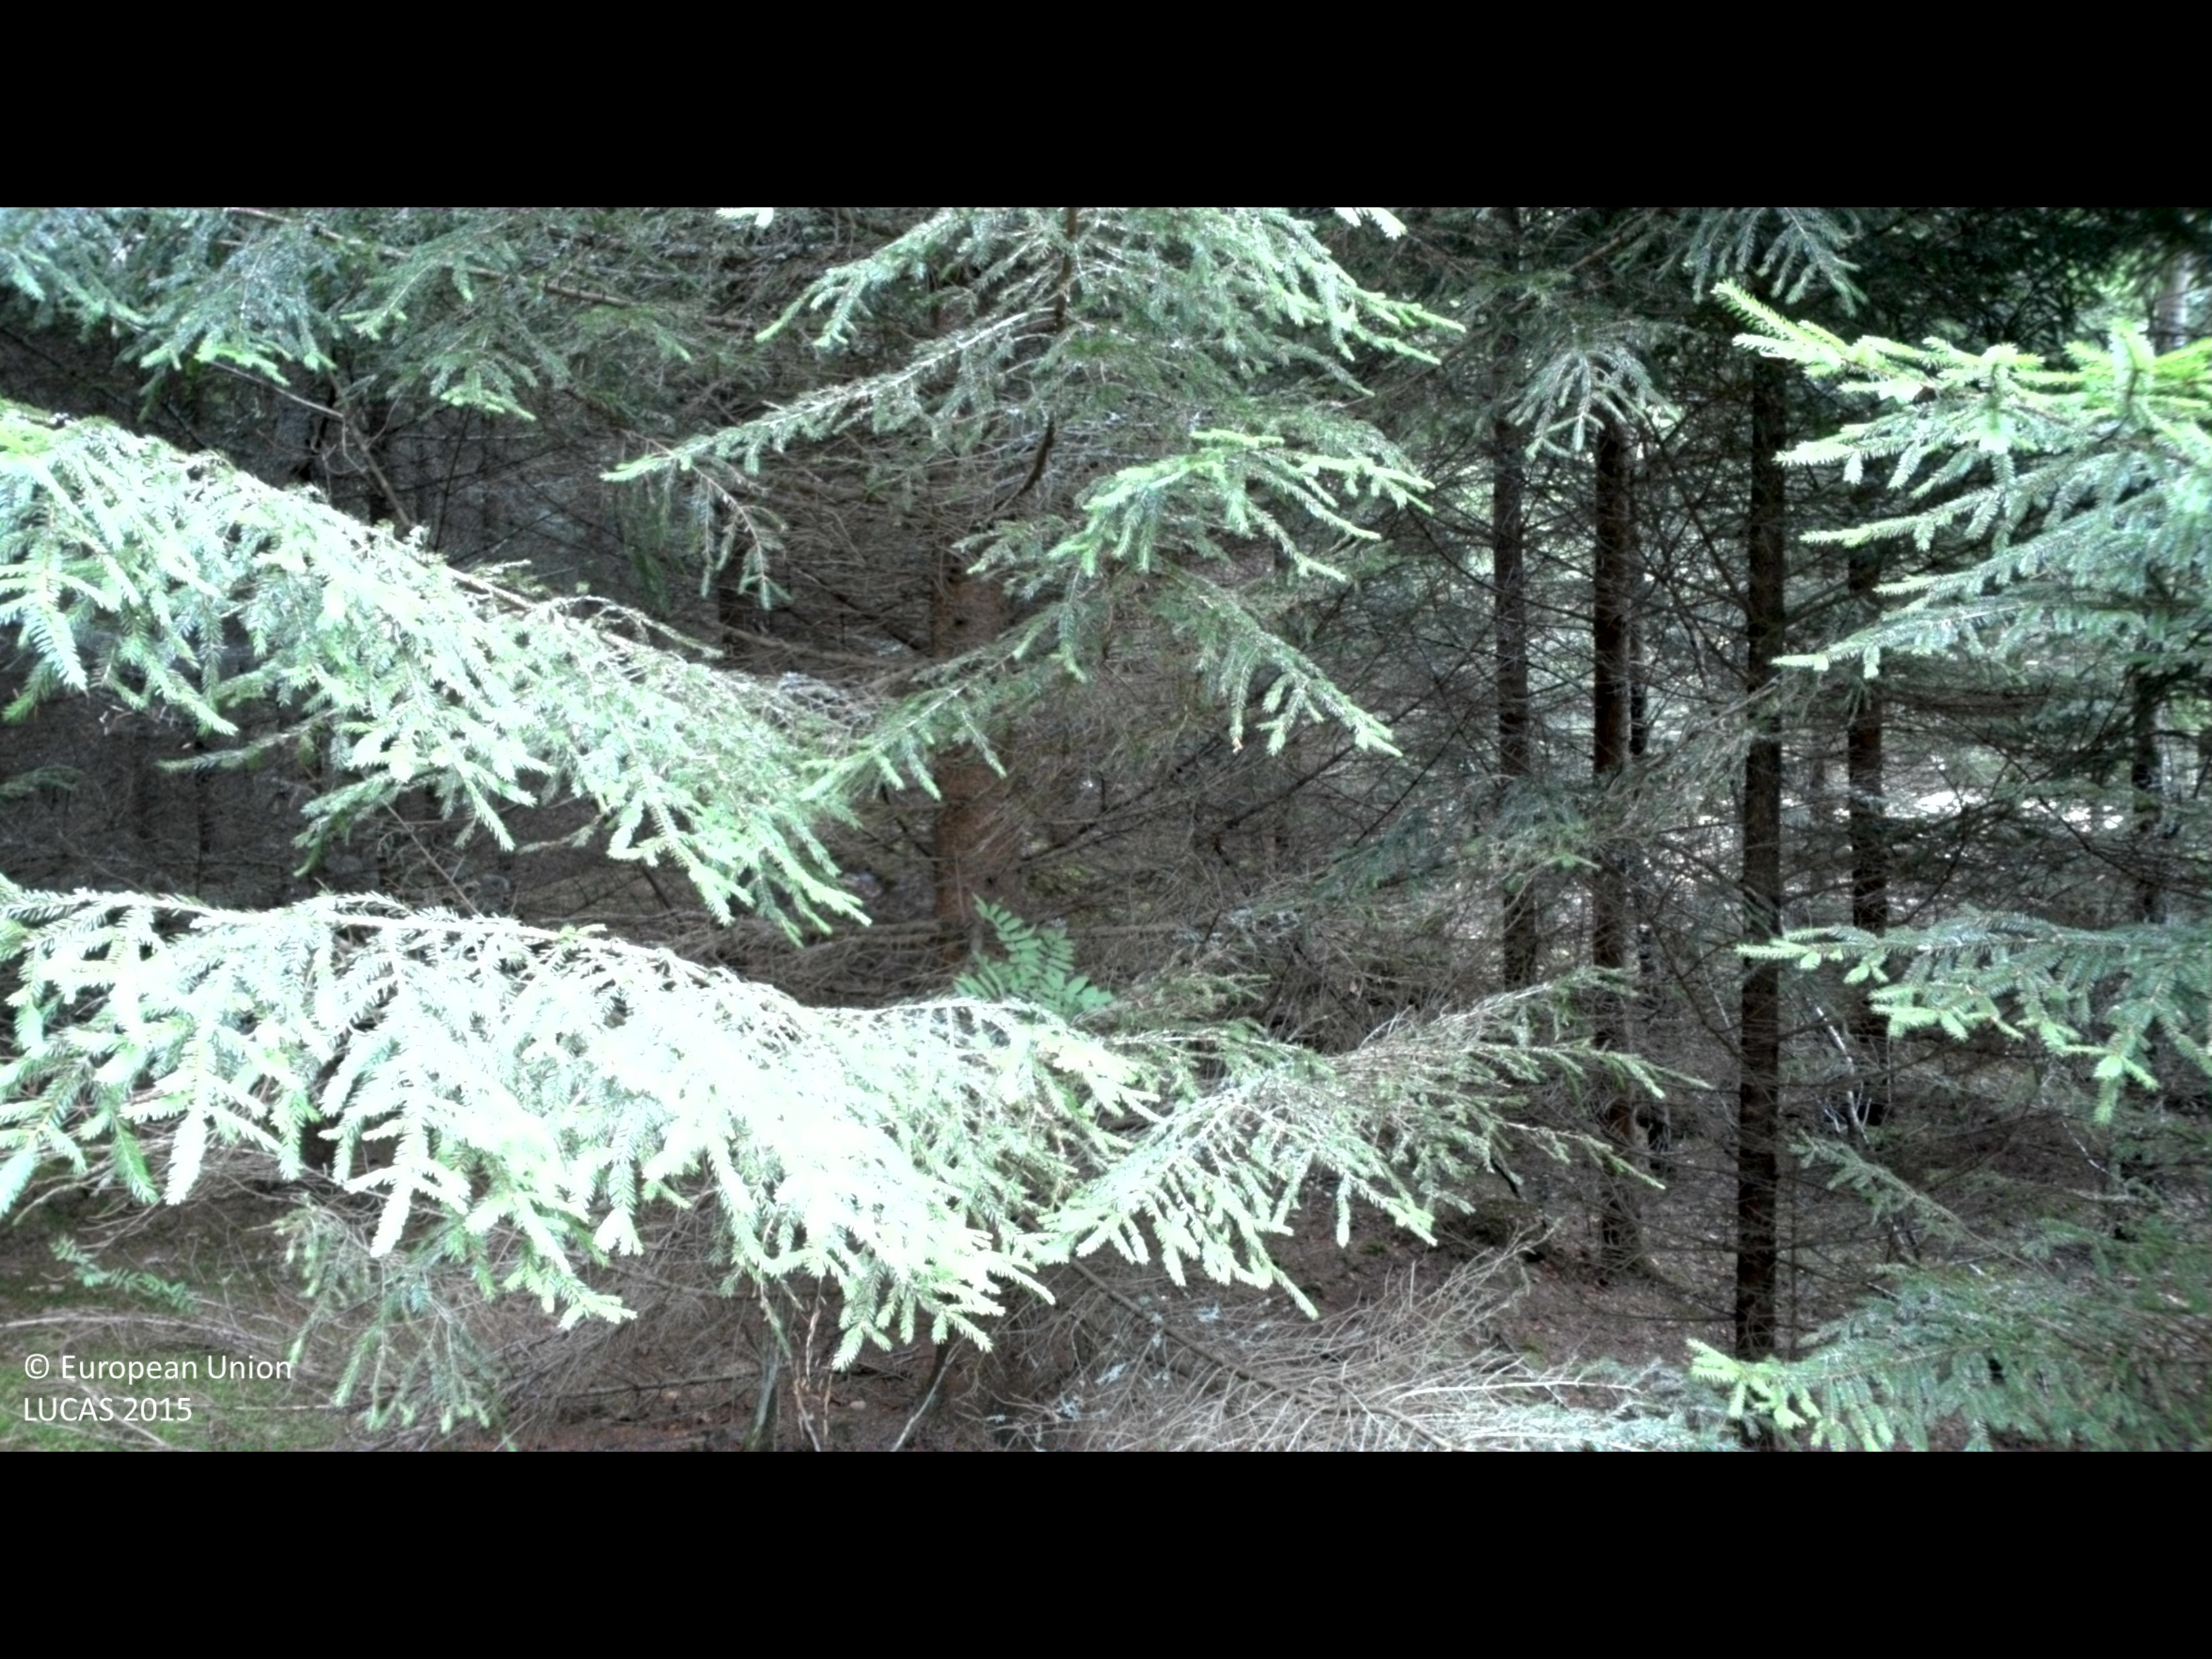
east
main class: Woodland
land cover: Spruce dominated coniferous woodland
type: boreal forest
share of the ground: 50 - 75 %
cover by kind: coniferous forest trees 65 %, lichens and mosses 25 %, broadleaved forest trees 5 %, herbaceous plants 5 %
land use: Forestry
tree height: > 5 m
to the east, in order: Spruce dominated coniferous woodland; Dry stone walls; Spruce dominated coniferous woodland; Dry stone walls; Spruce dominated coniferous woodland; Dry stone walls; Spruce dominated coniferous woodland; Dry stone walls; Spruce dominated coniferous woodland
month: August
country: SE
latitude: 56.3018
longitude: 15.1217
